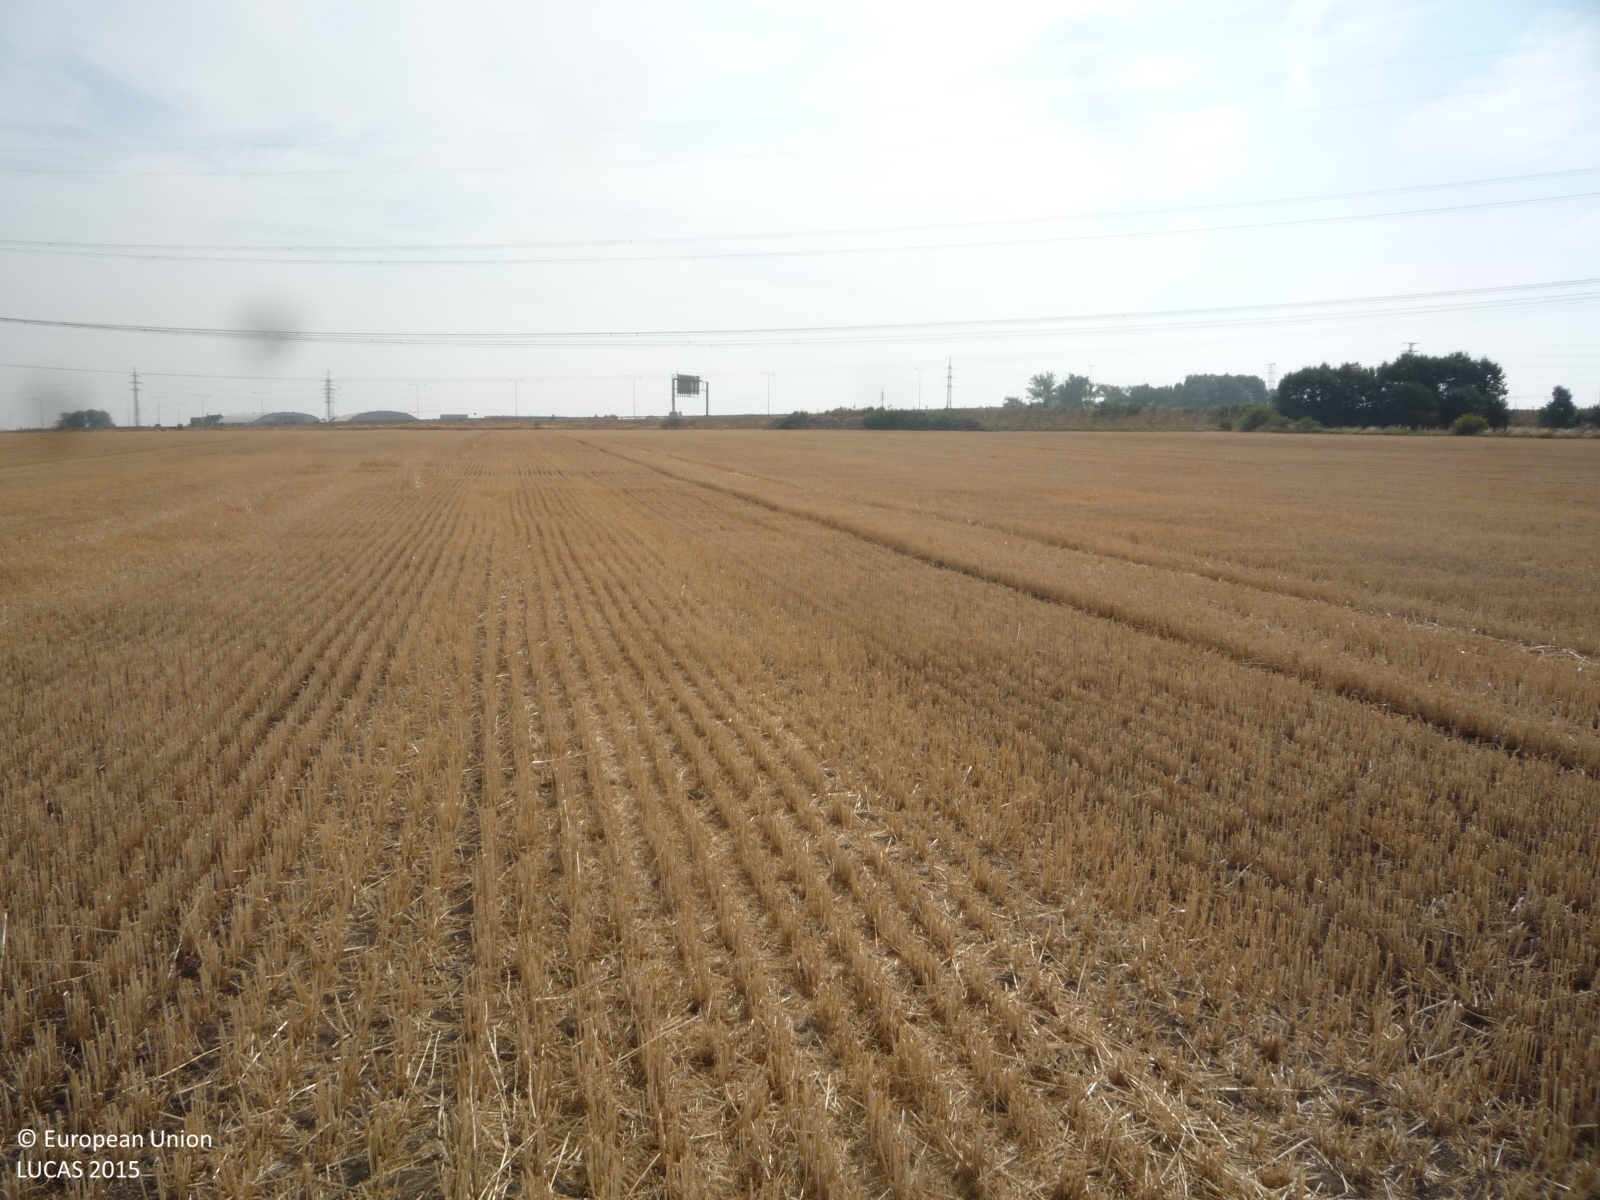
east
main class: Cropland
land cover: Common wheat
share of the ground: 25 - 50 %
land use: Agriculture (excluding fallow land and kitchen gardens)
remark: Harvested field
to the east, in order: Common wheat; Electric lines; Common wheat
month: August
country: CZ
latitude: 49.9882
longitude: 14.4788
